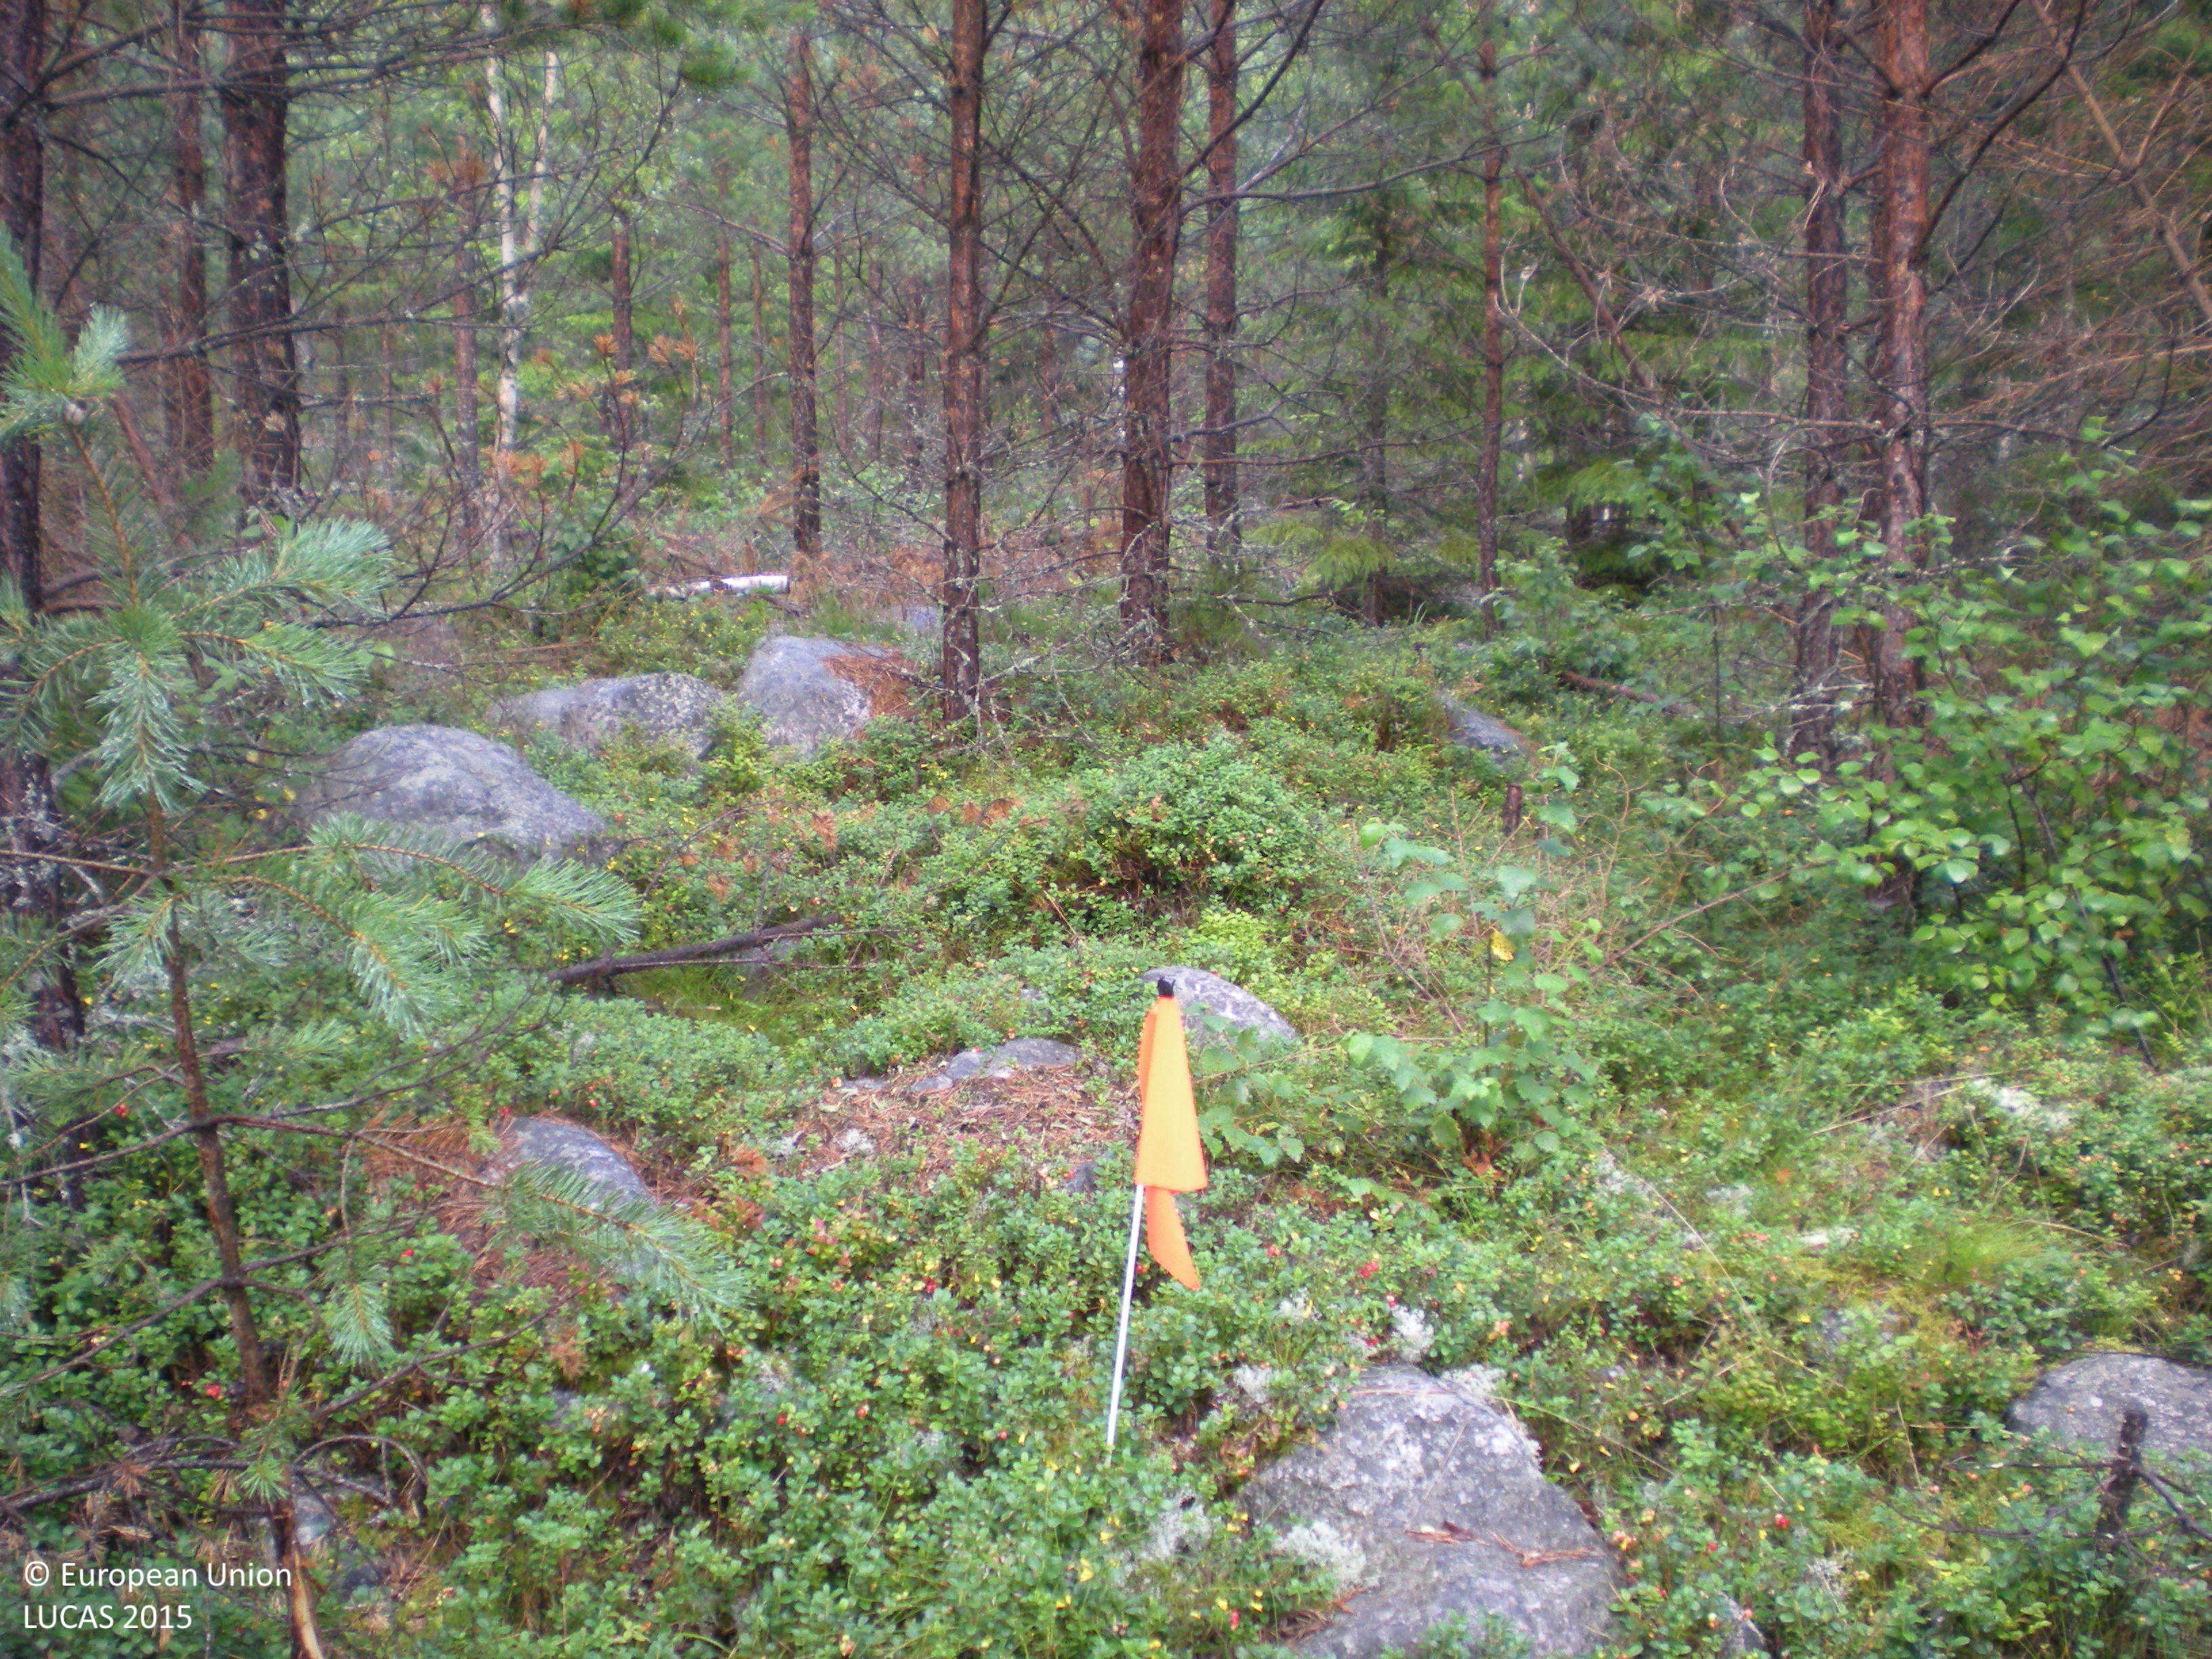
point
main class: Woodland
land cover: Pine dominated coniferous woodland
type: boreal forest
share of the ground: 50 - 75 %
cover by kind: coniferous forest trees 65 %, shrubs 15 %, broadleaved forest trees 5 %, herbaceous plants 5 %, lichens and mosses 5 %, consolidated bare surface 5 %
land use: Forestry
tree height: < 5 m
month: August
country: SE
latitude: 60.7349
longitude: 17.2694
